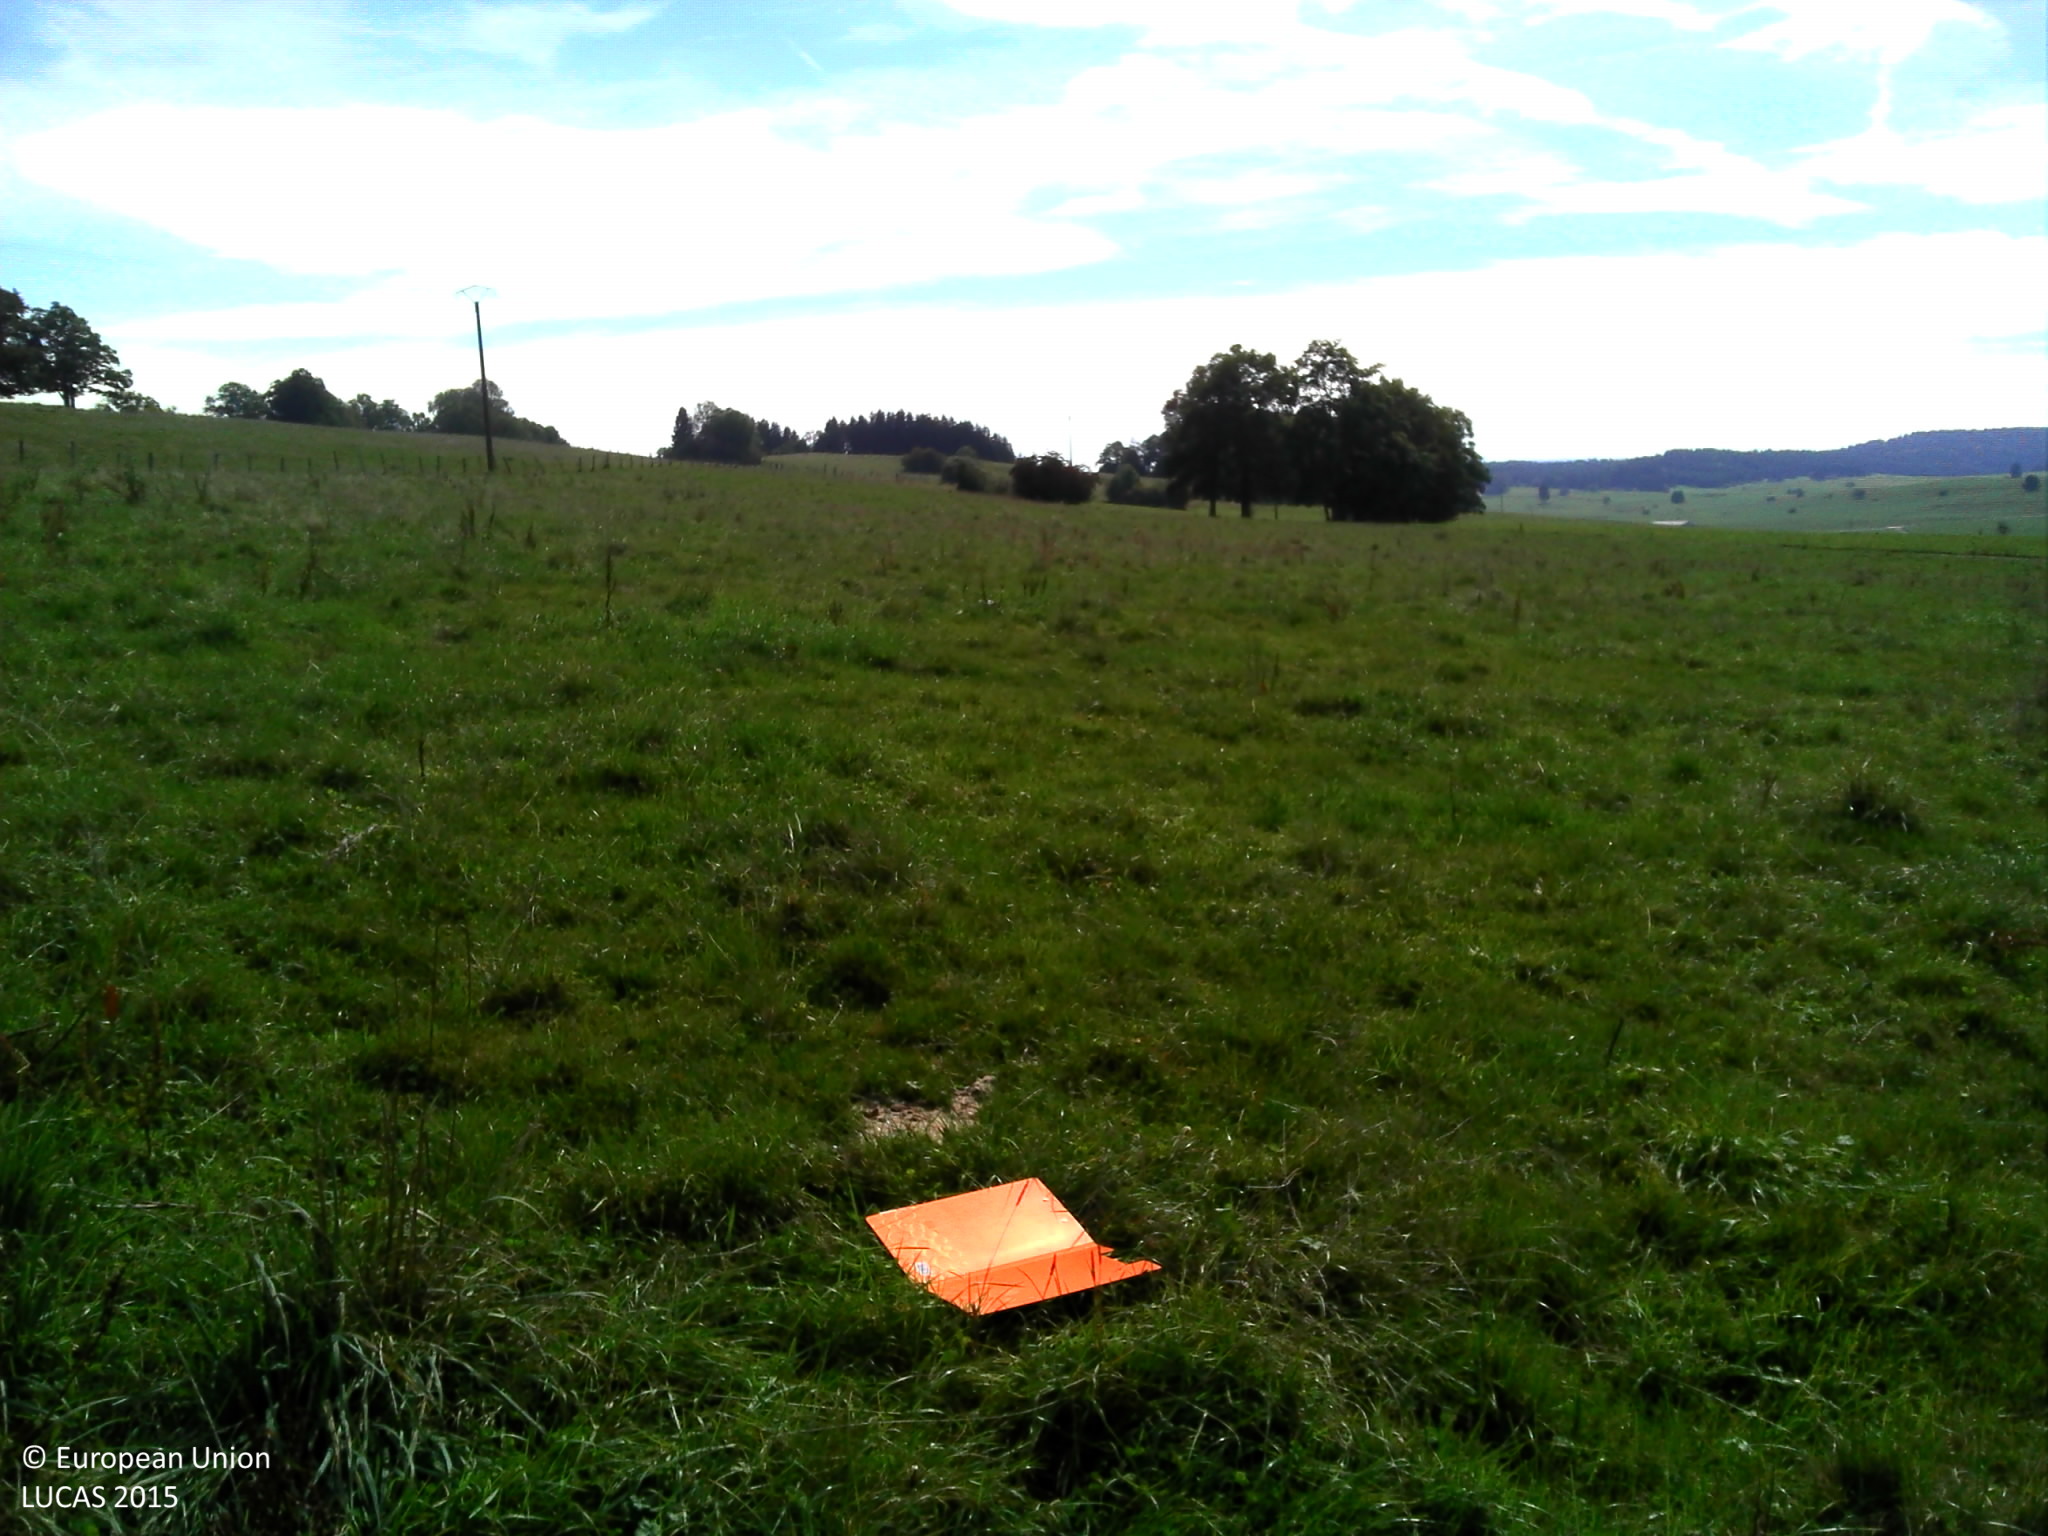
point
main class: Grassland
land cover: Grassland without tree/shrub cover
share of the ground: > 75 %
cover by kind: herbaceous plants 100 %
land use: Agriculture (excluding fallow land and kitchen gardens)
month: October
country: FR
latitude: 46.9914
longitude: 6.3337
